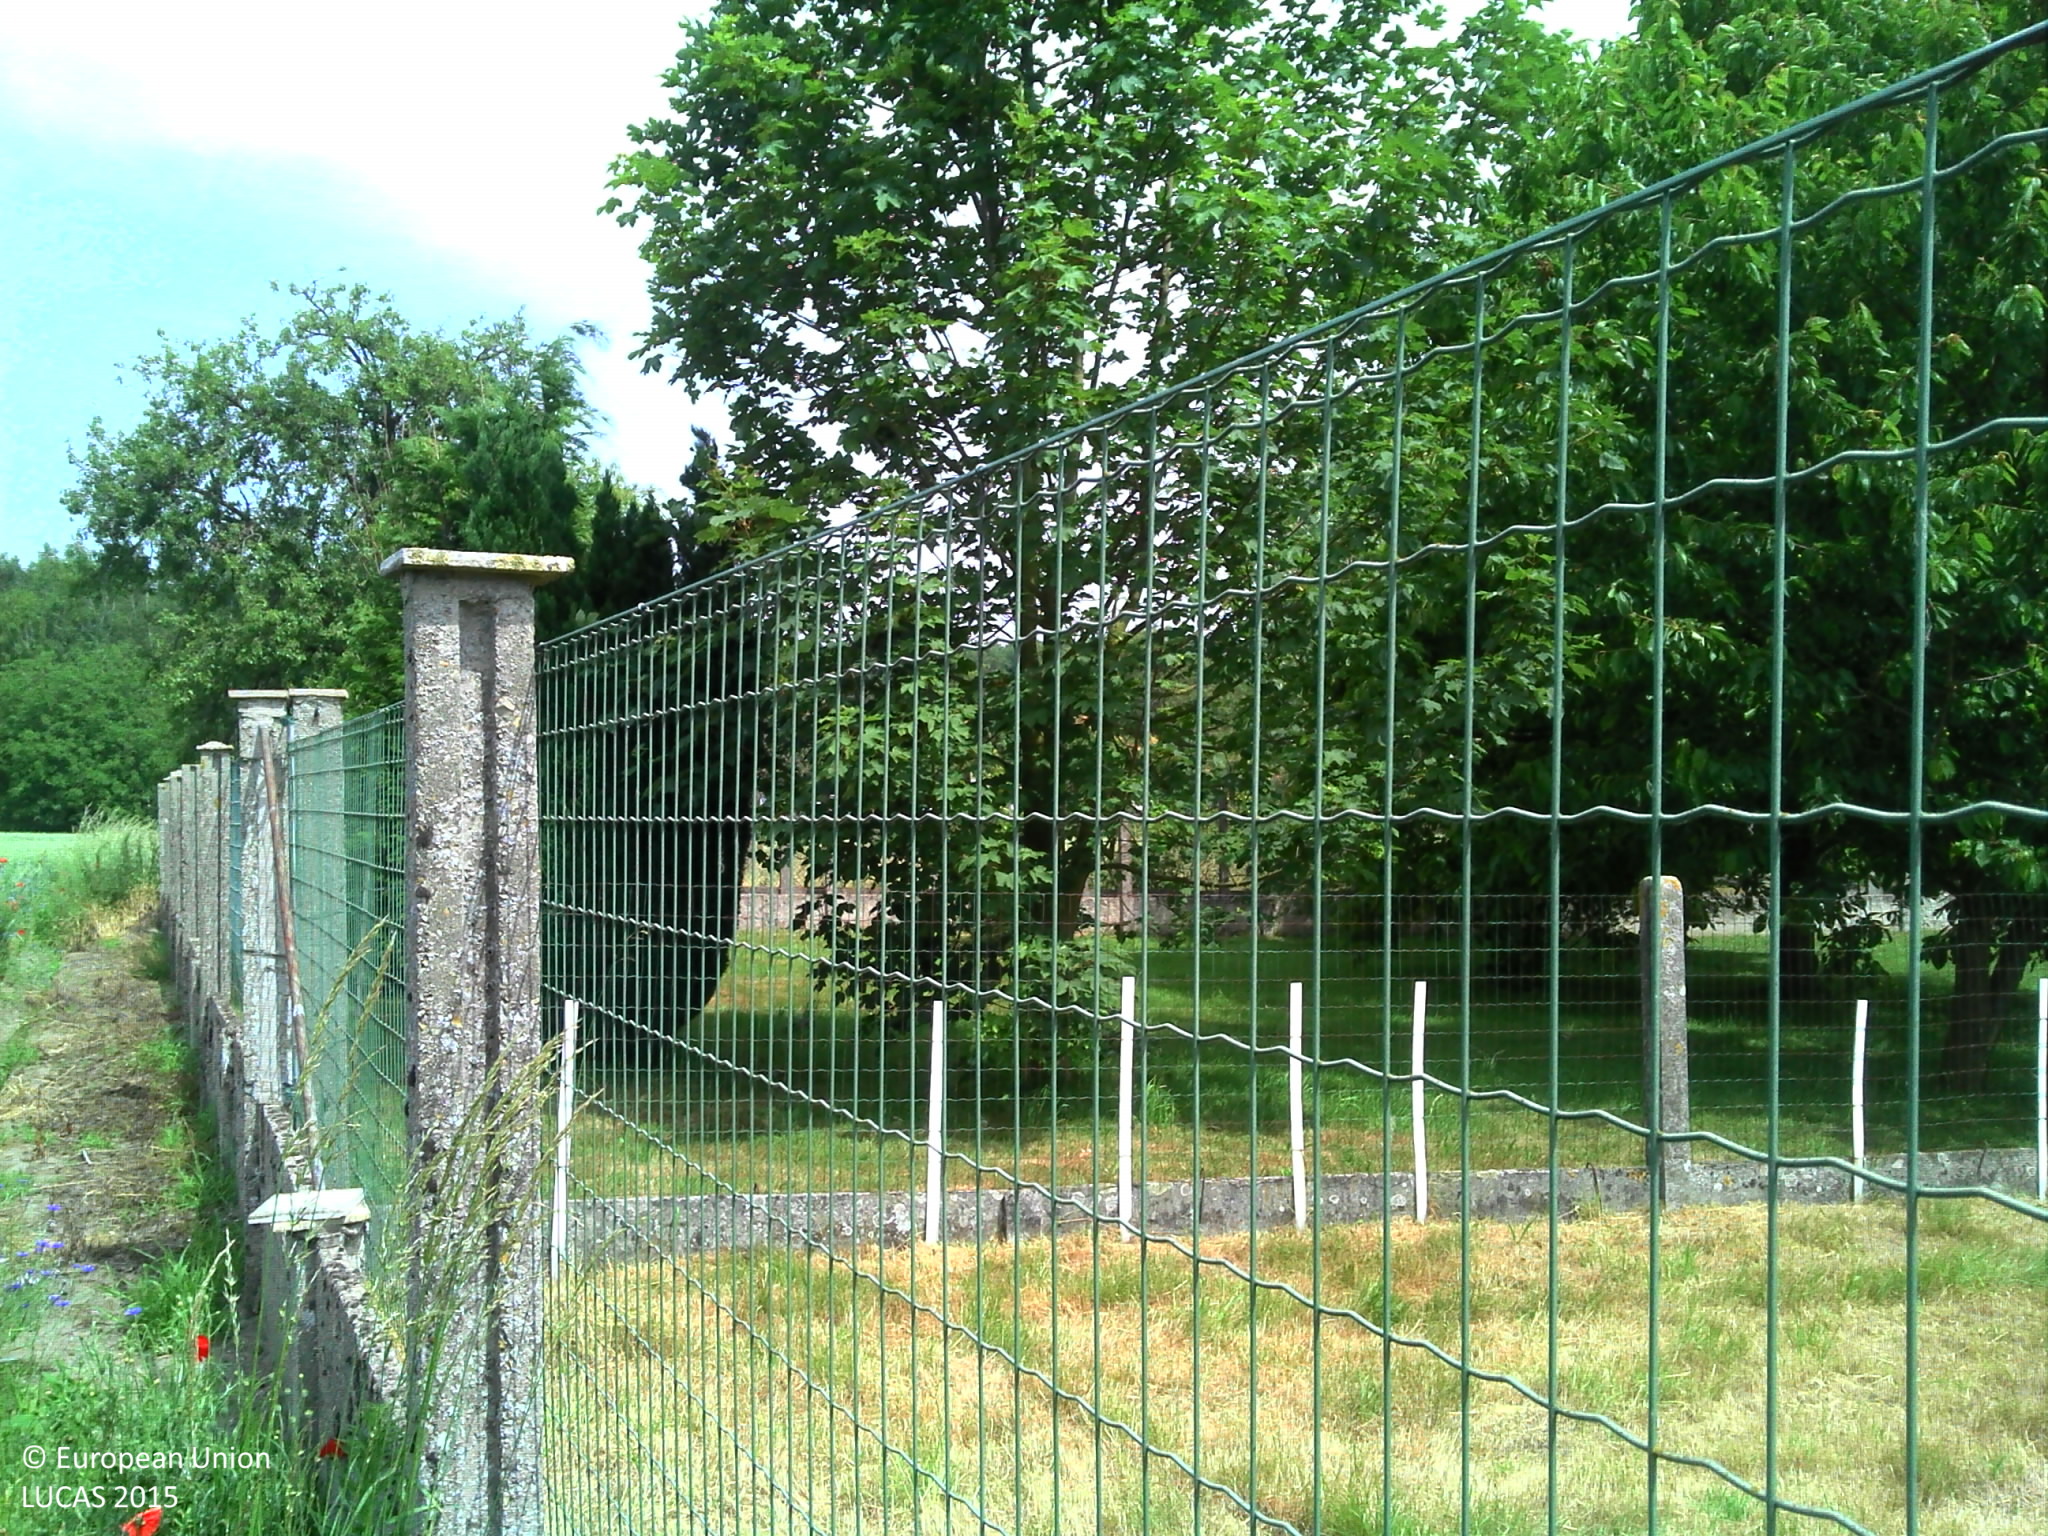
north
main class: Grassland
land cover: Grassland with sparse tree/shrub cover
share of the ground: > 75 %
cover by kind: herbaceous plants 95 %, broadleaved forest trees 5 %
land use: Residential
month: June
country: BE
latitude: 50.4817
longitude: 3.7502
